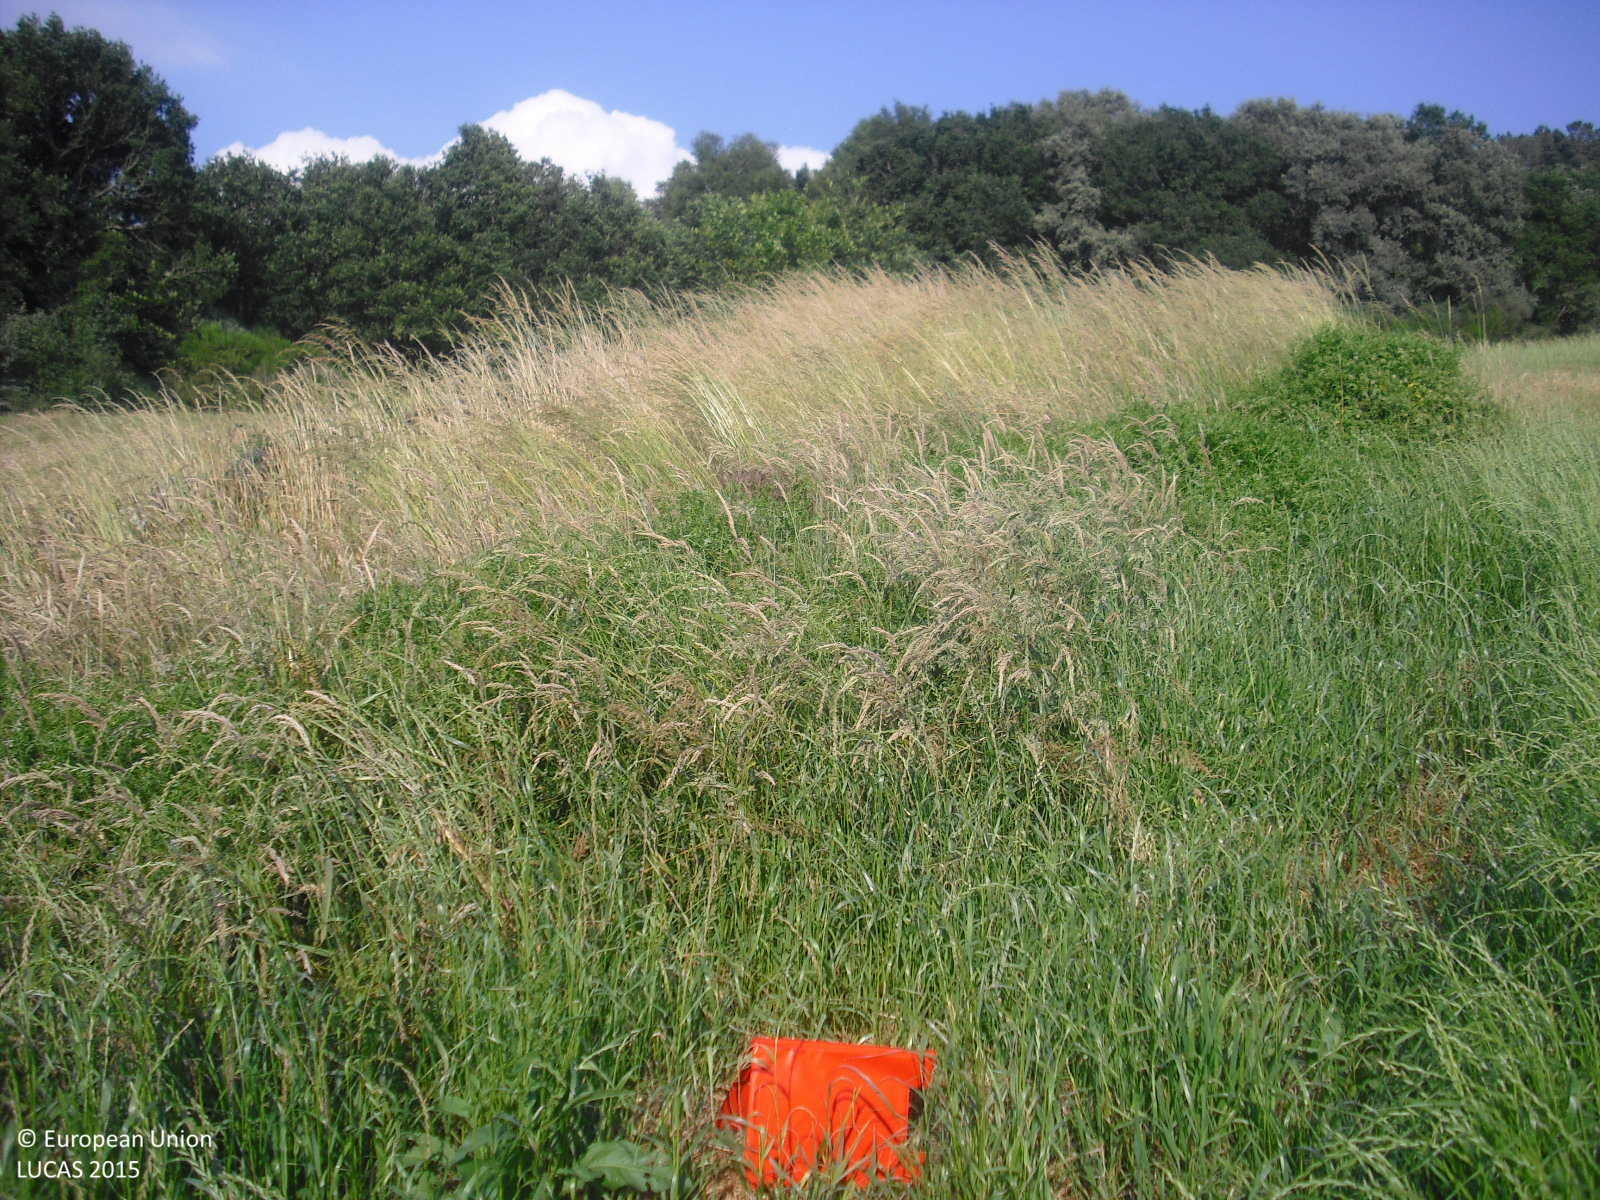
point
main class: Cropland
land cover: Temporary grasslands
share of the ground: > 75 %
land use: Agriculture (excluding fallow land and kitchen gardens)
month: June
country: ES
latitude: 42.5874
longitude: -7.8339
